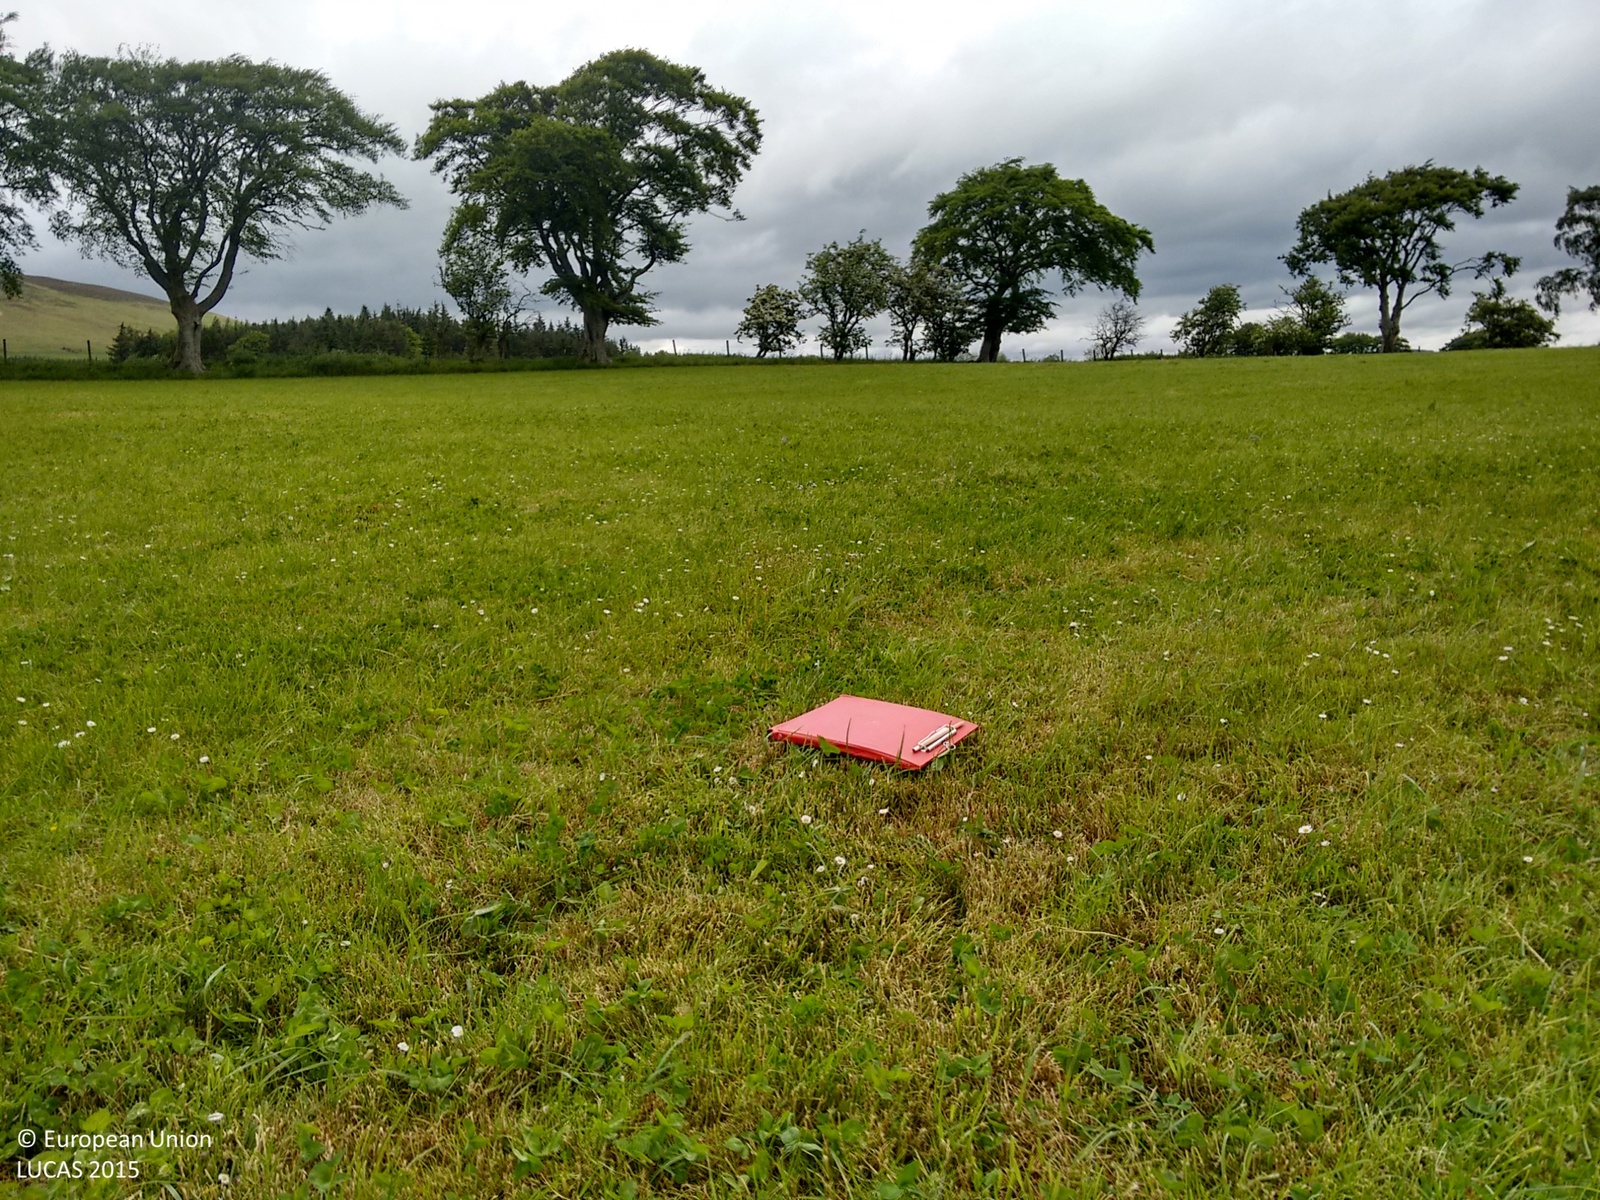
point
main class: Grassland
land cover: Grassland without tree/shrub cover
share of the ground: > 75 %
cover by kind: herbaceous plants 100 %
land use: Agriculture (excluding fallow land and kitchen gardens)
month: June
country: GB
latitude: 55.5854
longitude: -3.6139
